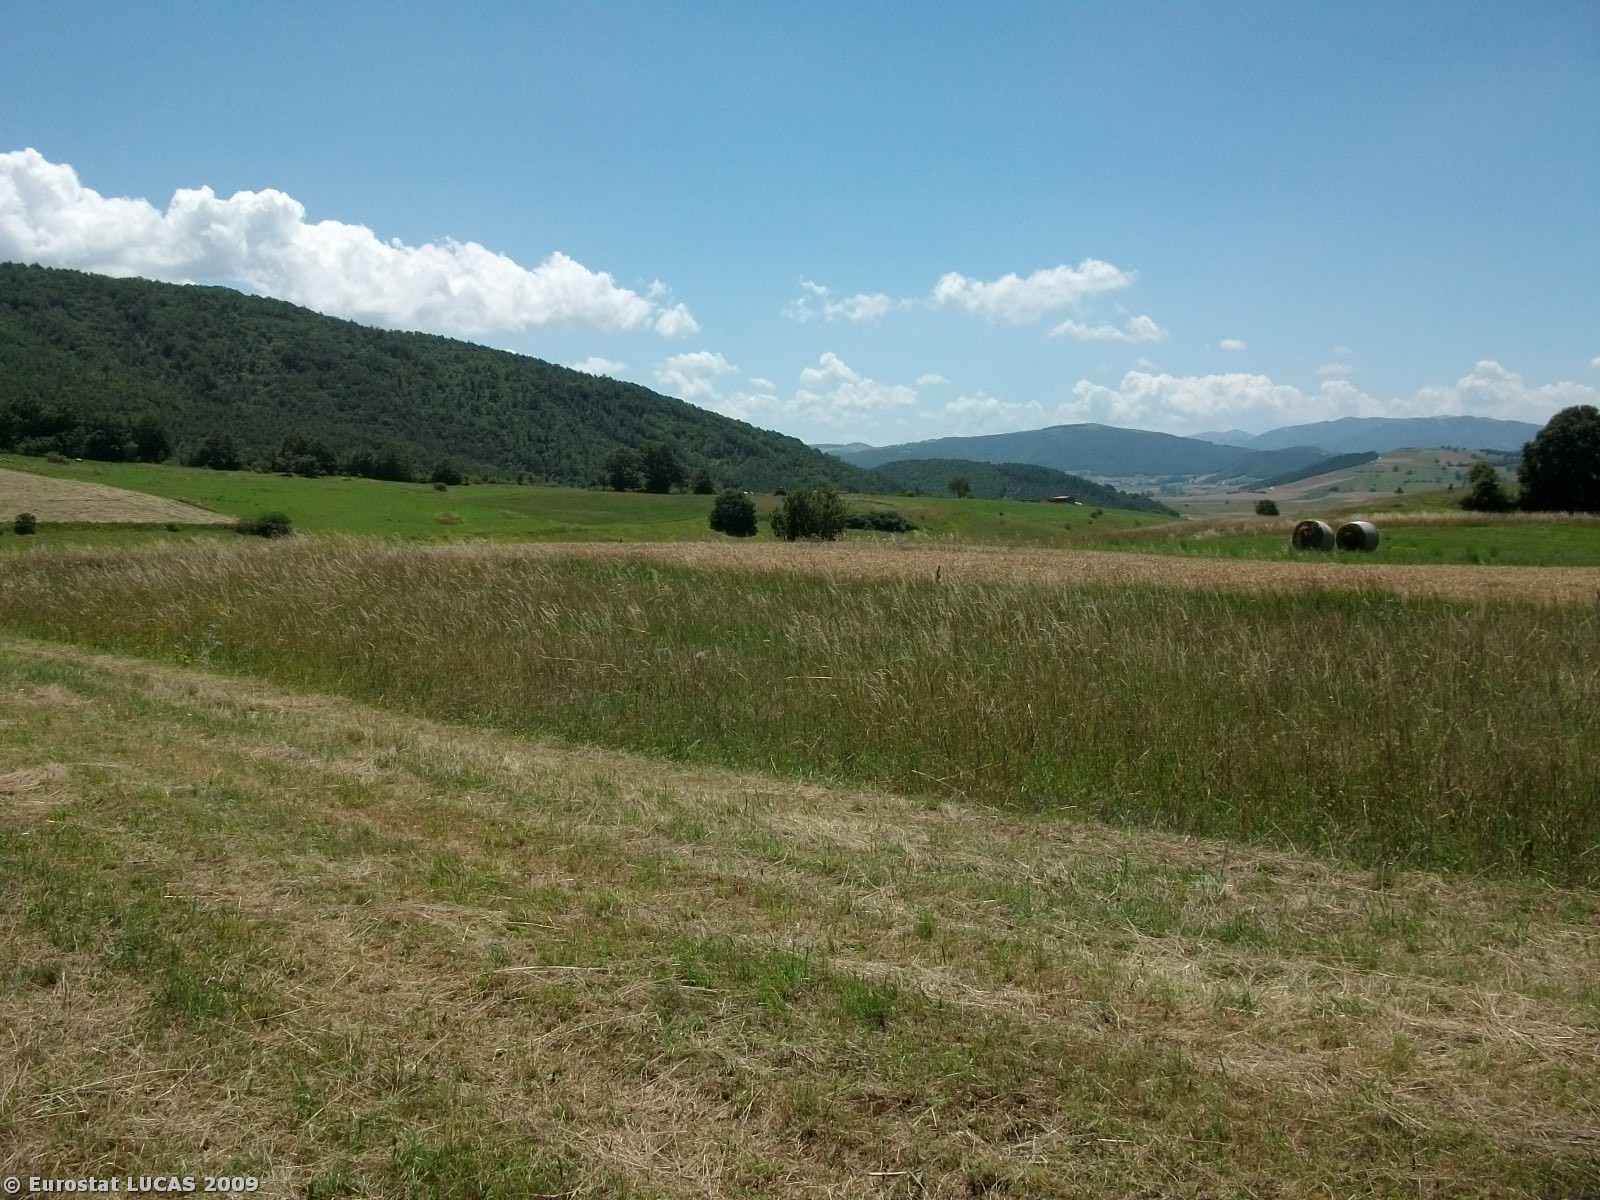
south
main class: Cropland
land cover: Temporary grasslands
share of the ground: > 75 %
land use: Agriculture (excluding fallow land and kitchen gardens)
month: July
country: IT
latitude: 43.0649
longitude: 12.8775
